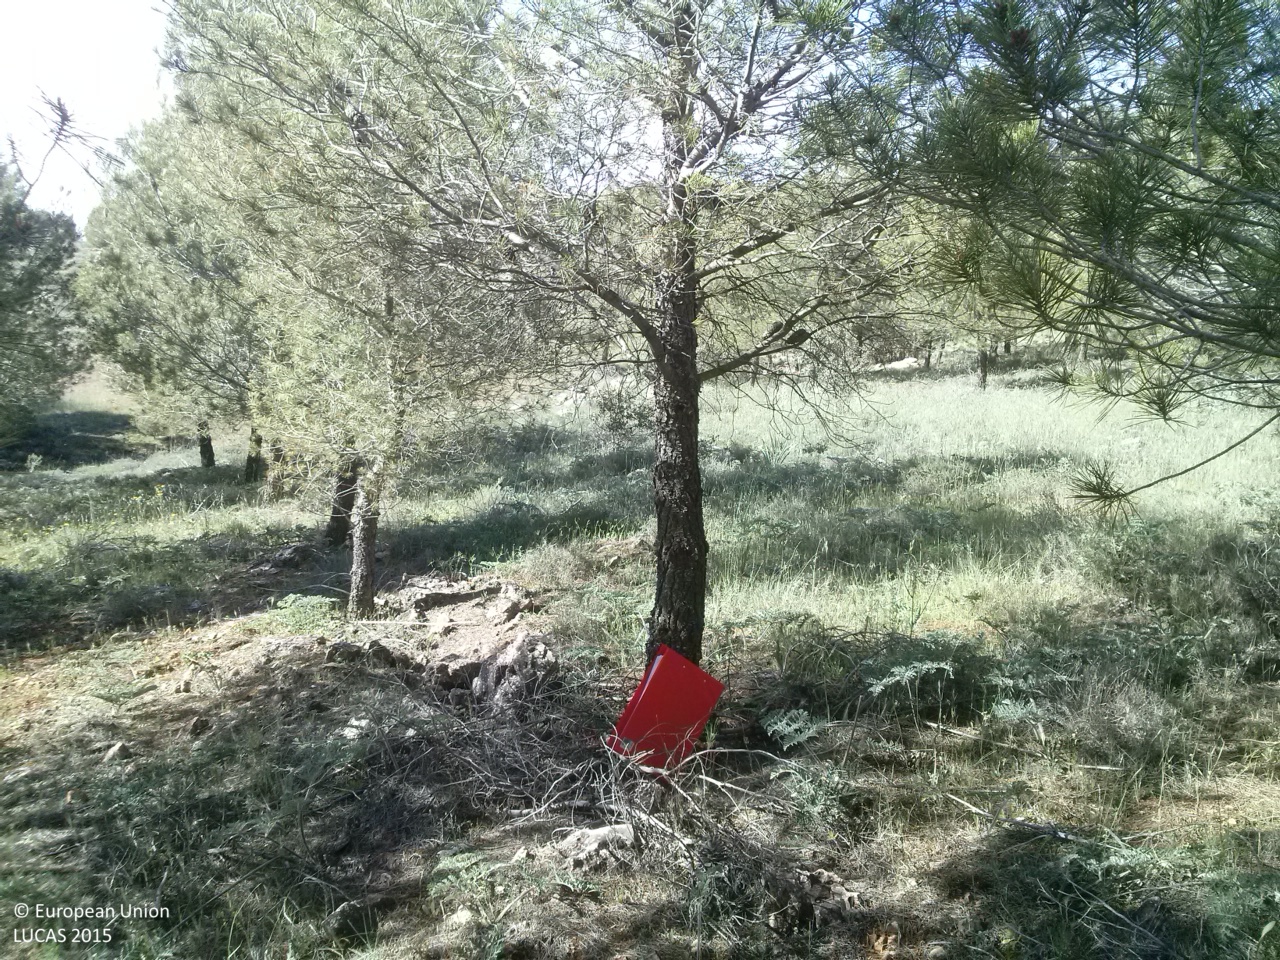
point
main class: Woodland
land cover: Pine dominated coniferous woodland
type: coniferous forest of the mediterranean region
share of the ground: 50 - 75 %
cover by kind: coniferous forest trees 65 %, herbaceous plants 25 %, consolidated bare surface 10 %
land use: Forestry
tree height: < 5 m
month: May
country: ES
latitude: 39.8320
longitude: -2.7670
